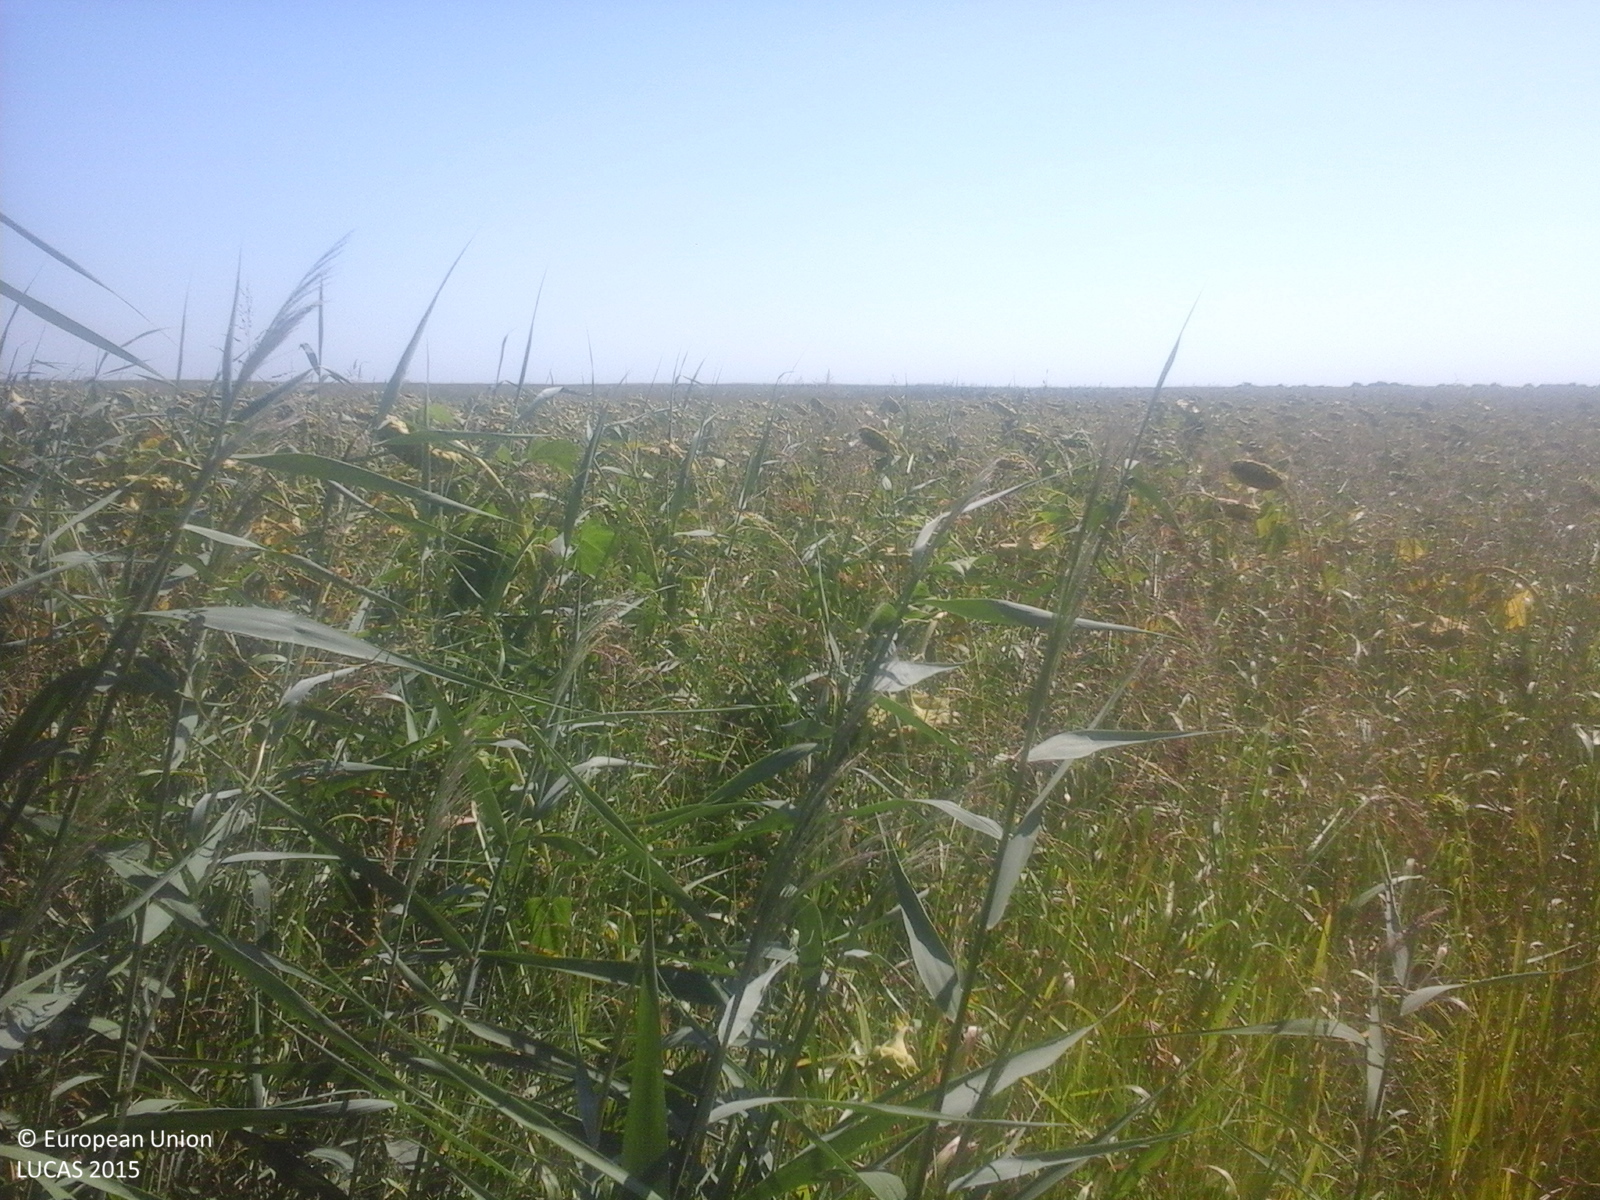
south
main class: Cropland
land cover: Sunflower
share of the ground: > 75 %
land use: Agriculture (excluding fallow land and kitchen gardens)
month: August
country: RO
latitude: 45.5632
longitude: 27.4620
